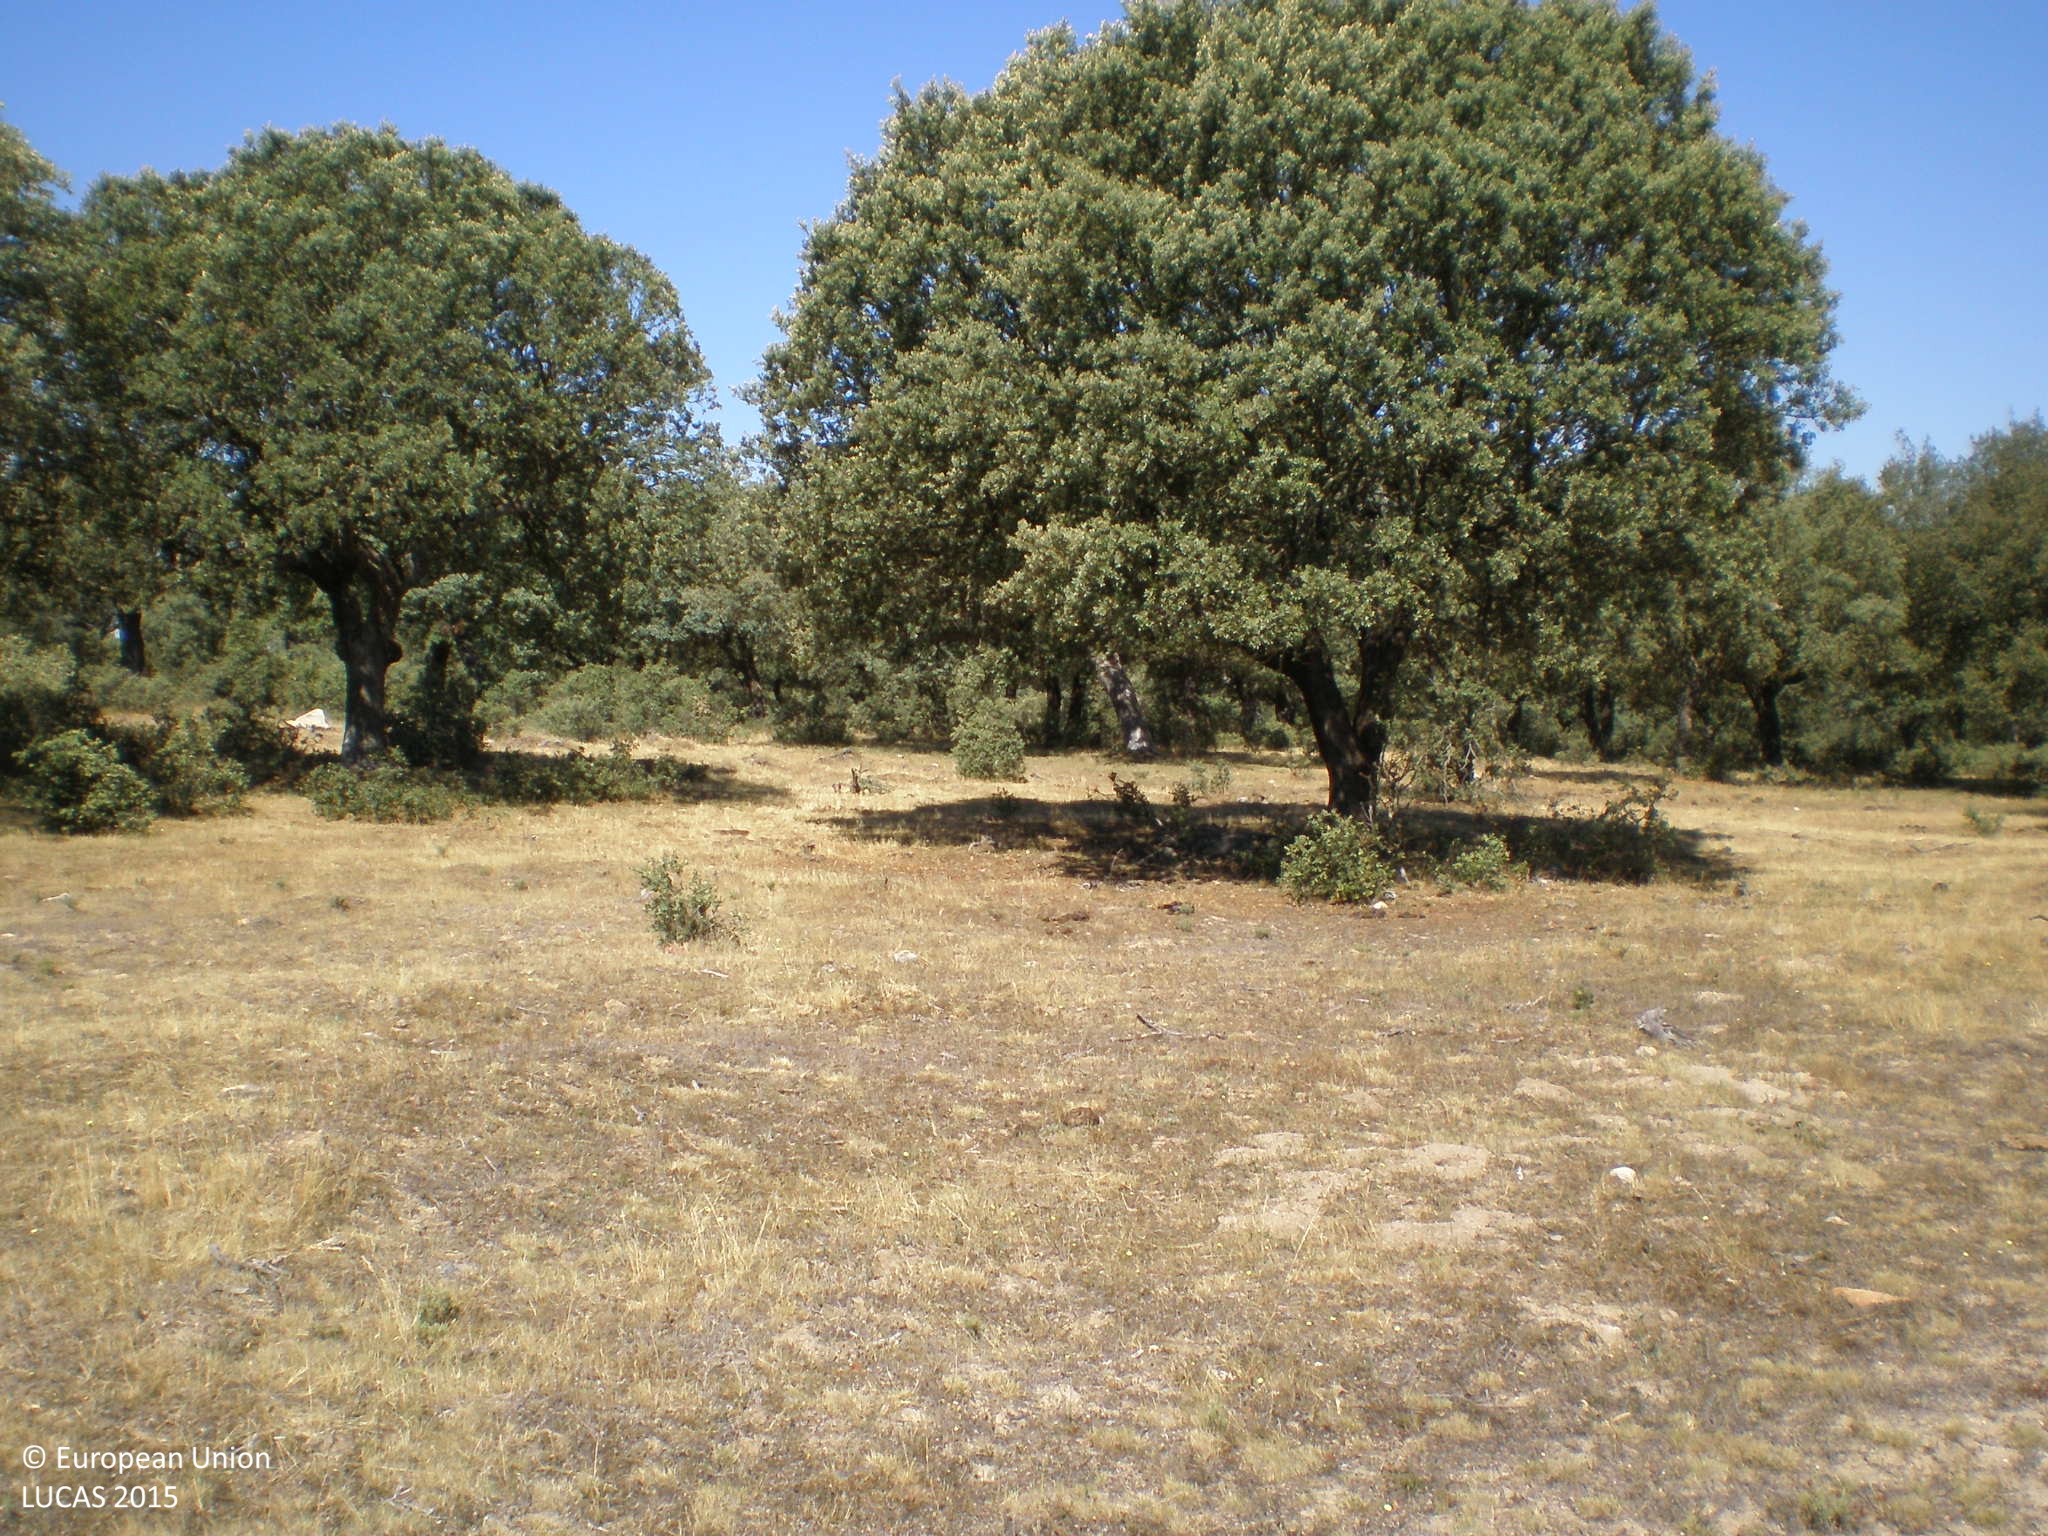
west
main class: Woodland
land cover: Broadleaved woodland
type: broadleaved evergreen forest
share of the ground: 25 - 50 %
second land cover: Grassland without tree/shrub cover
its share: 50 - 75 %
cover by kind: herbaceous plants 65 %, broadleaved forest trees 35 %
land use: Forestry
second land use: Agriculture (excluding fallow land and kitchen gardens)
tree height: > 5 m
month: June
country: ES
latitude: 40.8200
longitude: -5.6662
